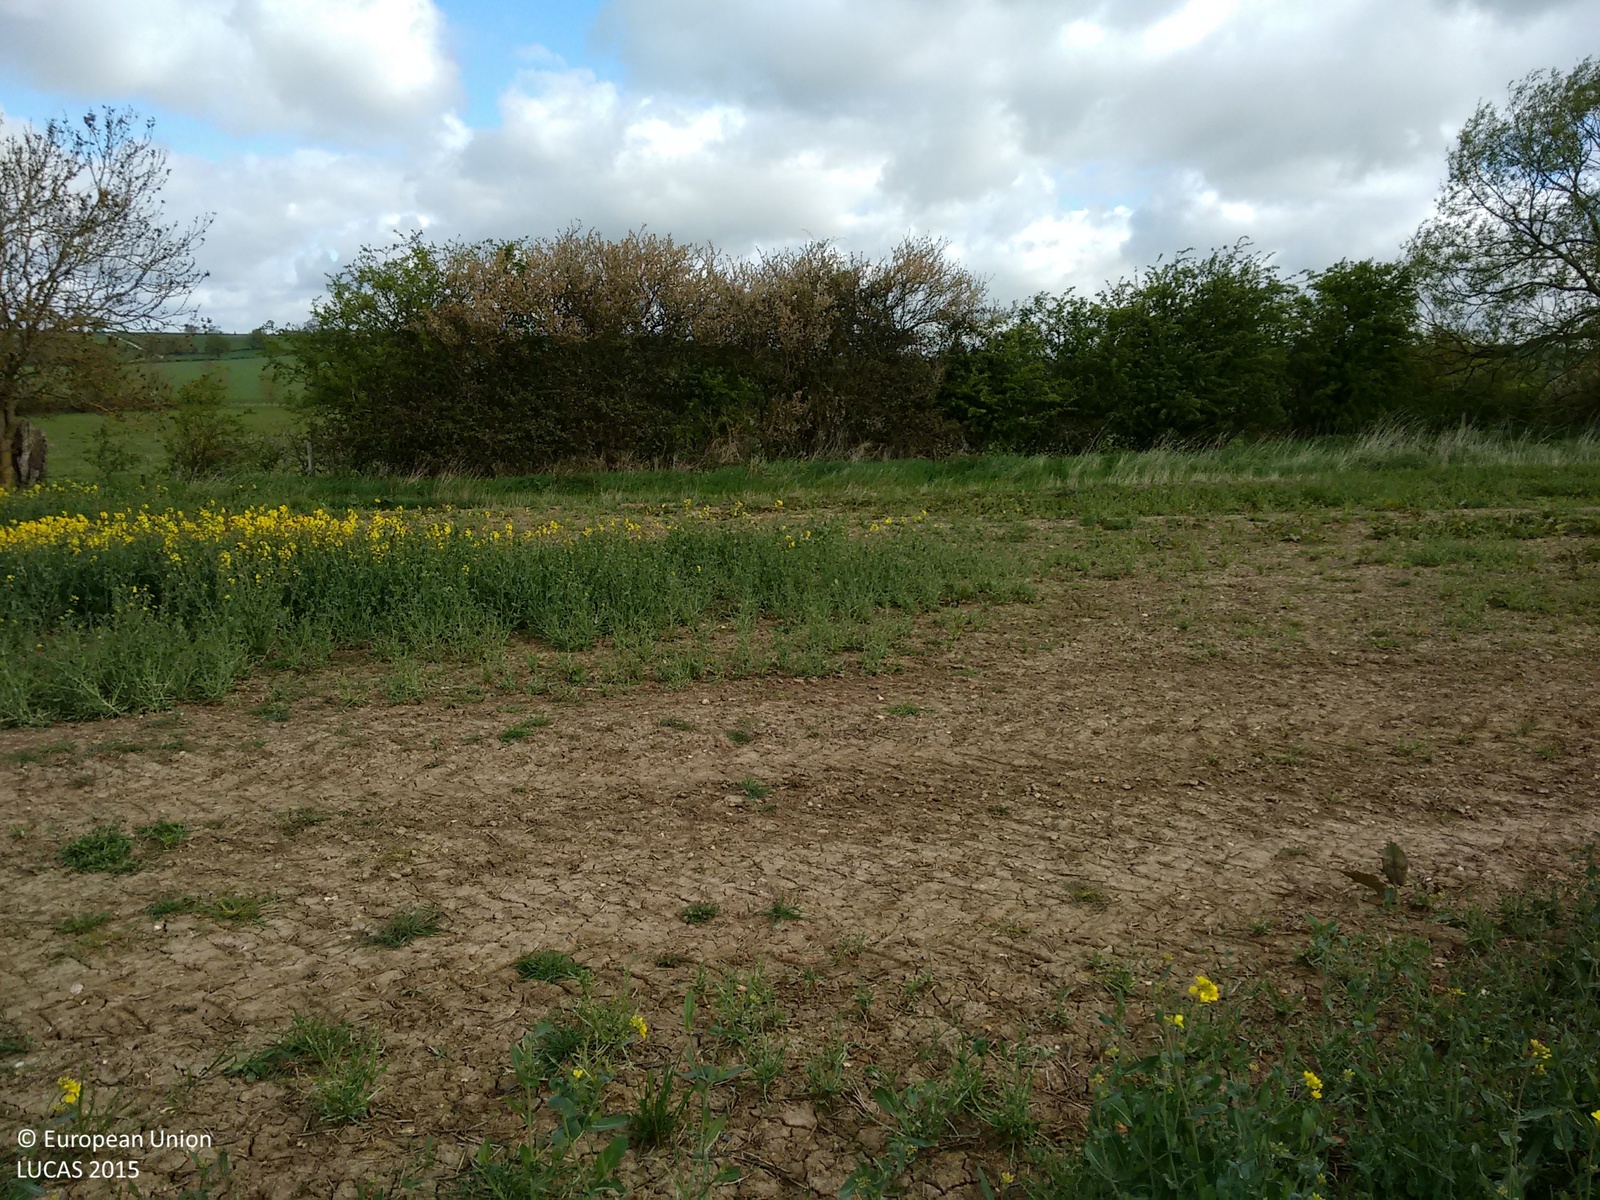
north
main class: Cropland
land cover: Rape and turnip rape
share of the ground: > 75 %
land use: Agriculture (excluding fallow land and kitchen gardens)
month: April
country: GB
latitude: 51.8470
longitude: -0.7985
